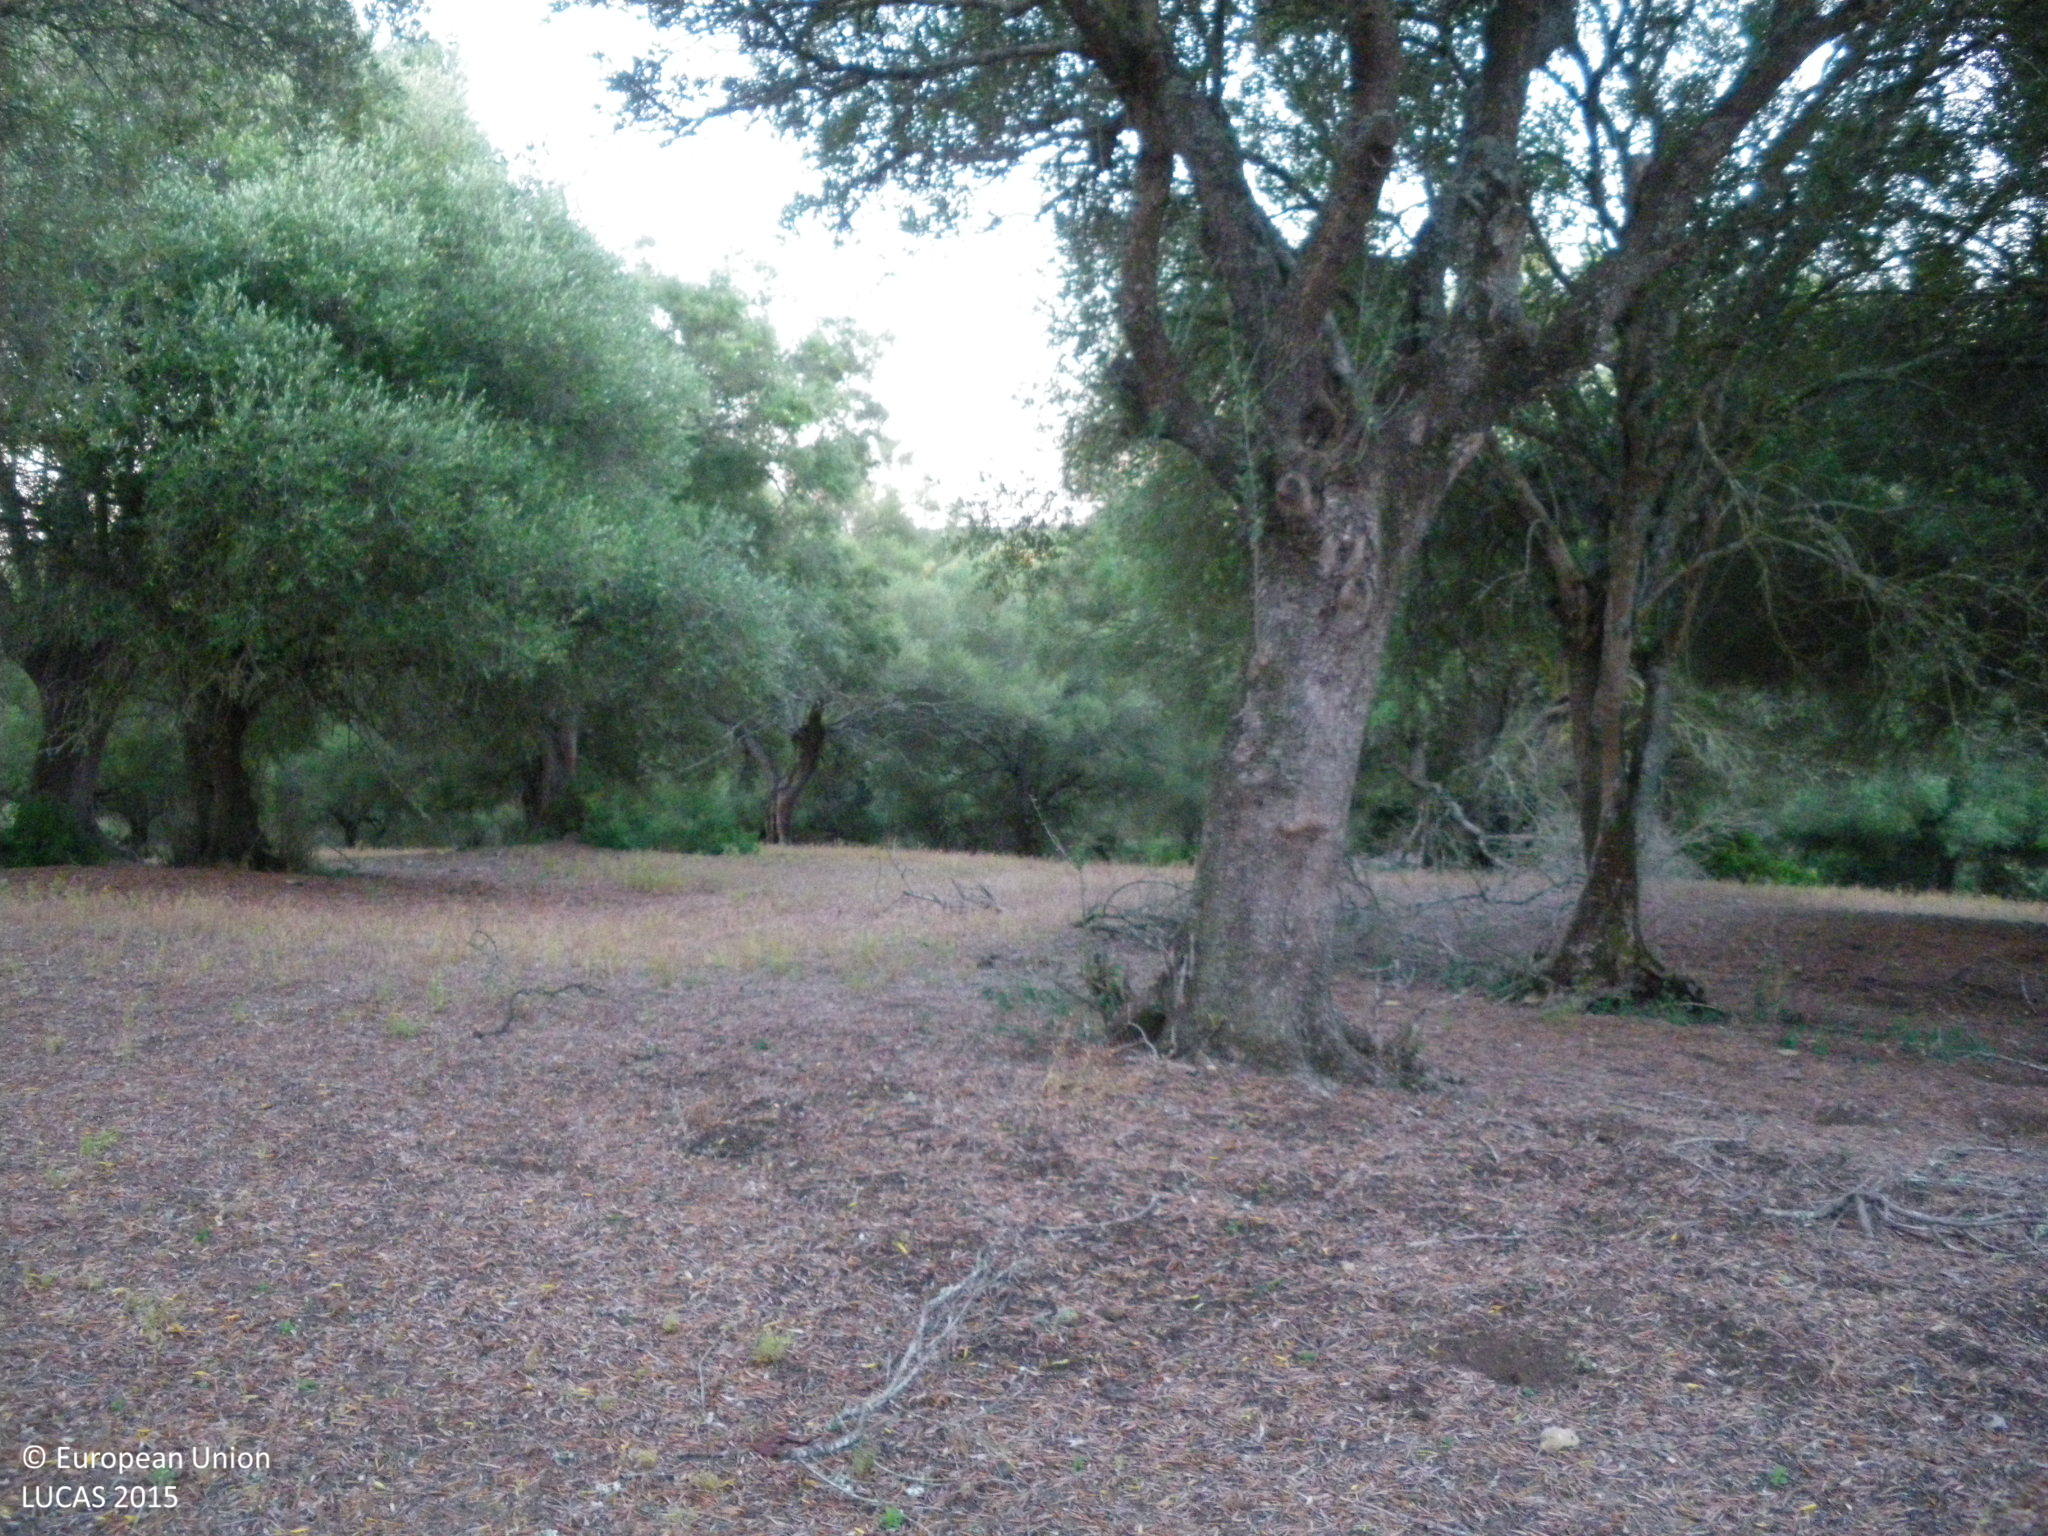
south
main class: Woodland
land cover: Broadleaved woodland
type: broadleaved evergreen forest
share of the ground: > 75 %
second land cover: Grassland without tree/shrub cover
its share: > 75 %
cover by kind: broadleaved forest trees 75 %, herbaceous plants 20 %, unconsolidated bare surface 5 %
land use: Forestry
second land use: Agriculture (excluding fallow land and kitchen gardens)
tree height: > 5 m
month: June
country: ES
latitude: 36.2701
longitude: -5.9073
